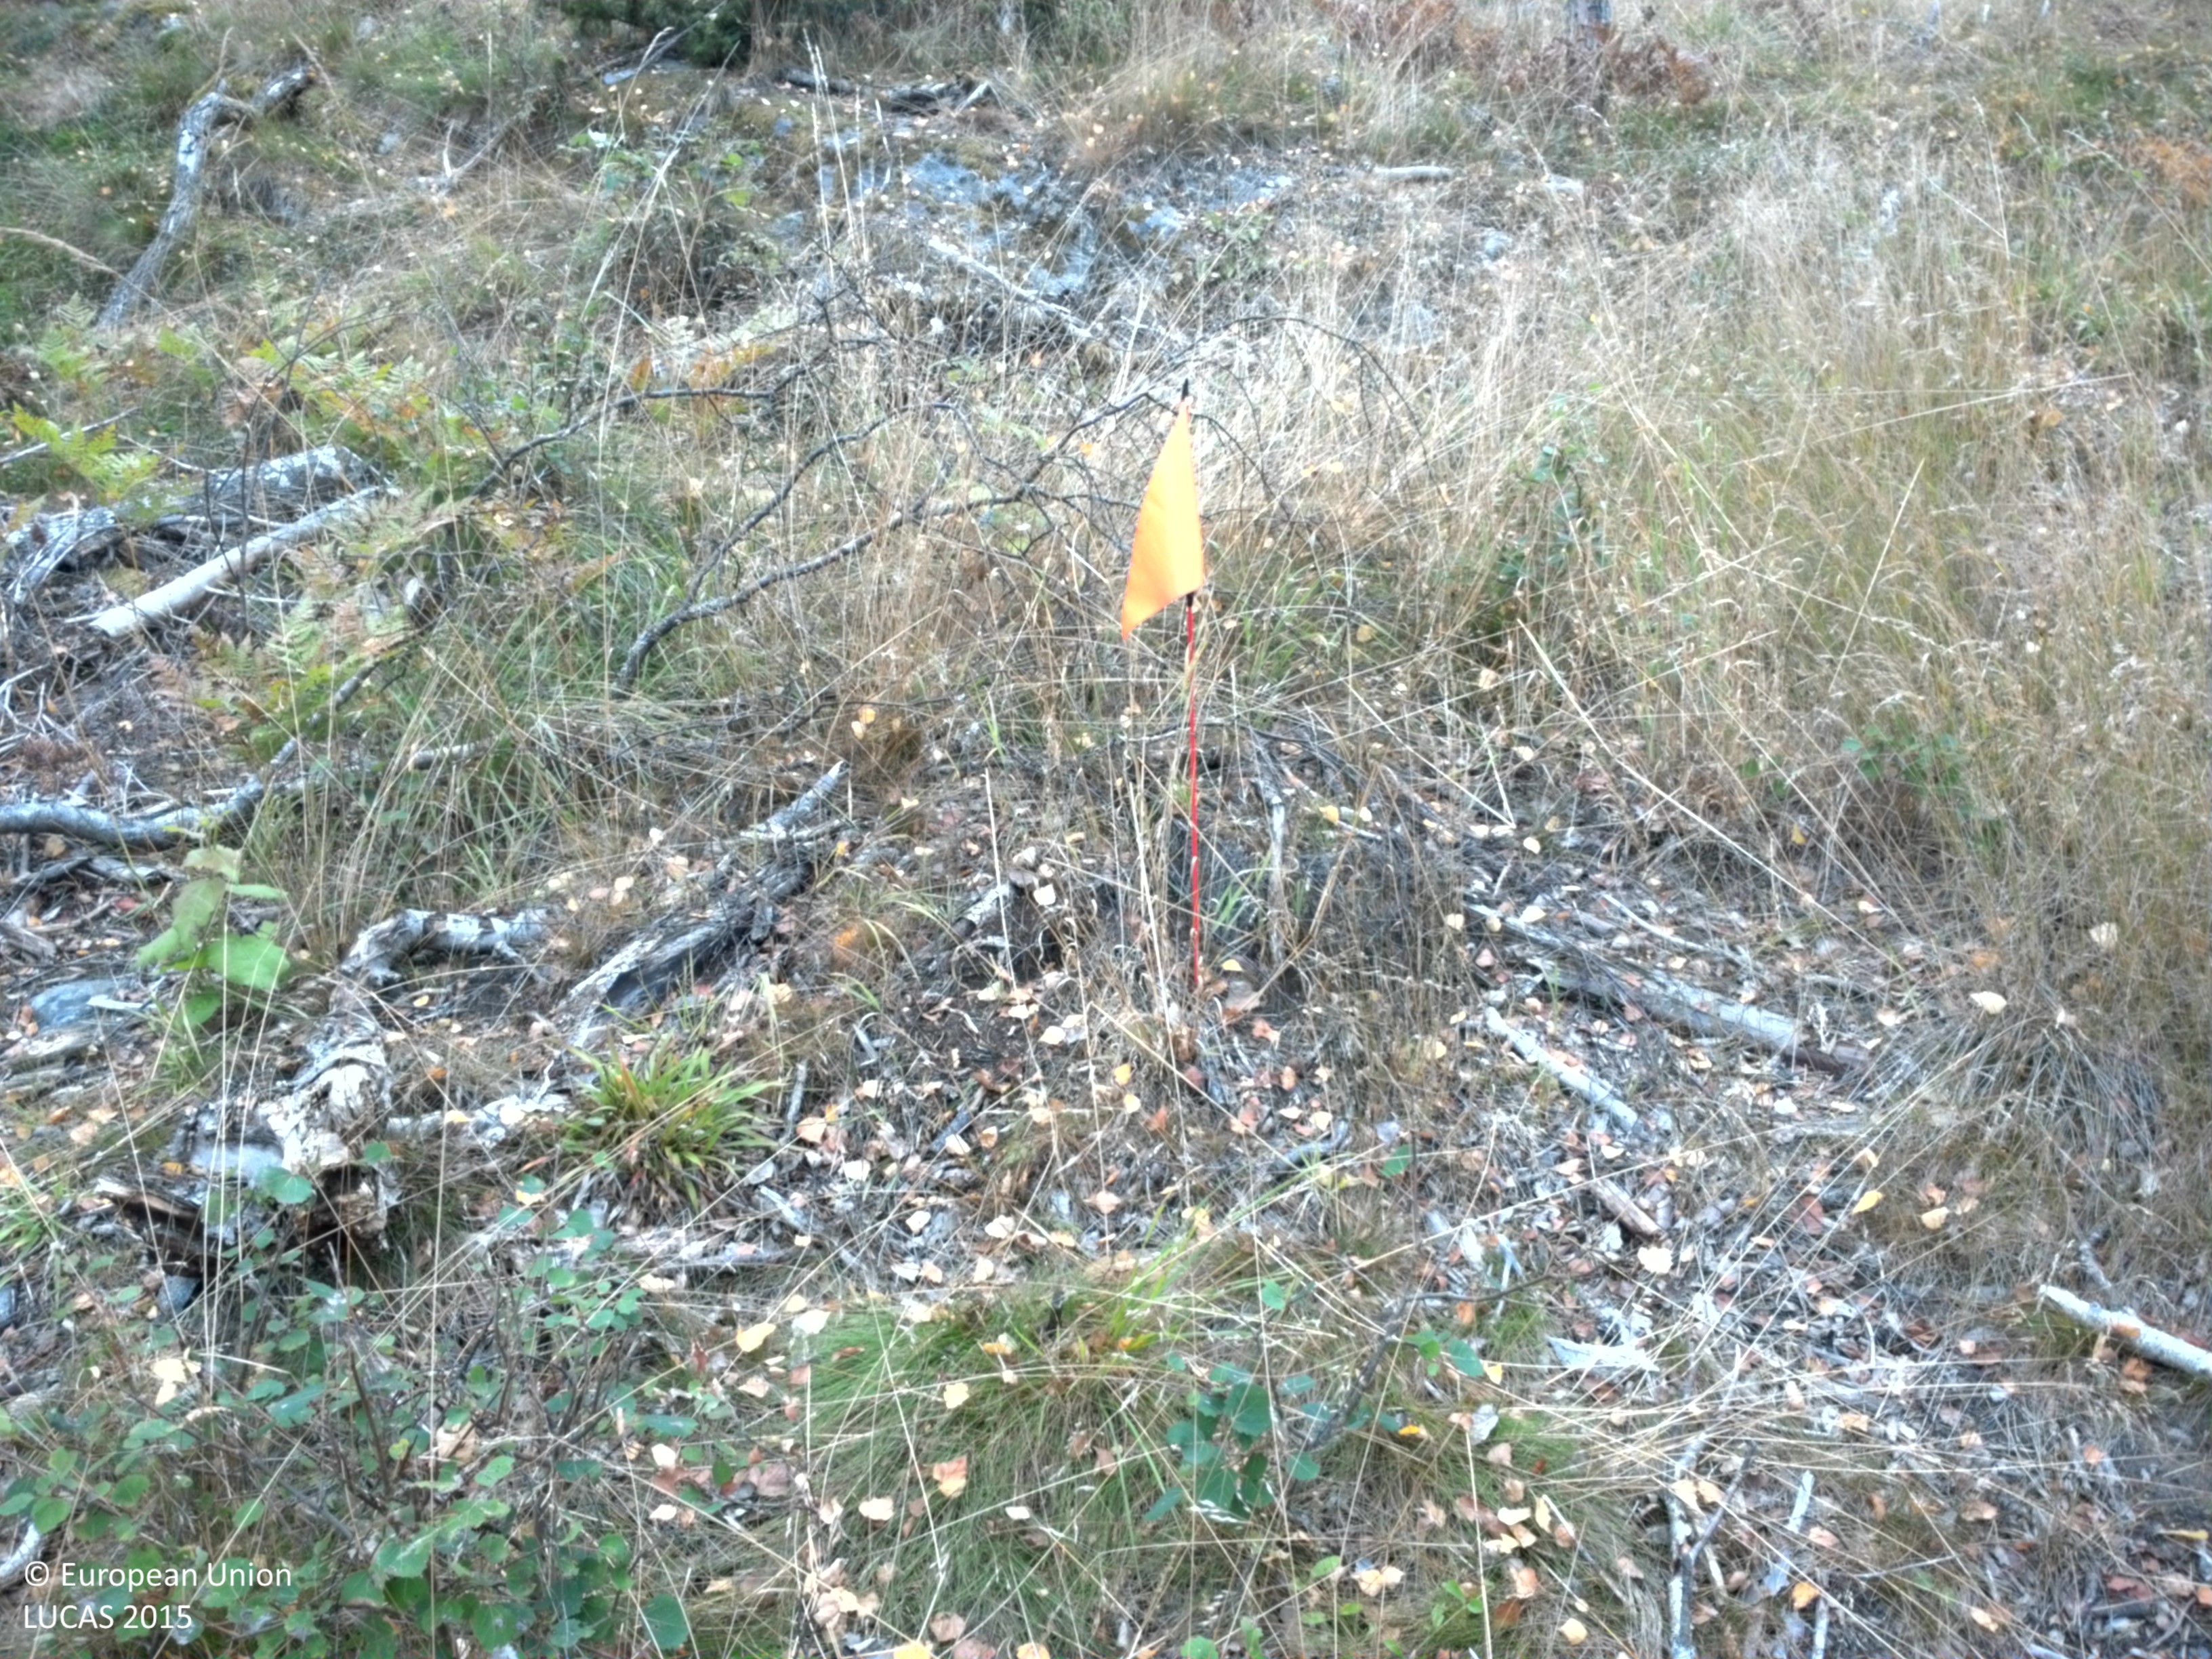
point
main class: Woodland
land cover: Broadleaved woodland
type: boreal forest
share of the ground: 50 - 75 %
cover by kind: broadleaved forest trees 50 %, herbaceous plants 40 %, coniferous forest trees 10 %
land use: Forestry
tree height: > 5 m
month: September
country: SE
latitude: 59.2953
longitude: 18.4109
